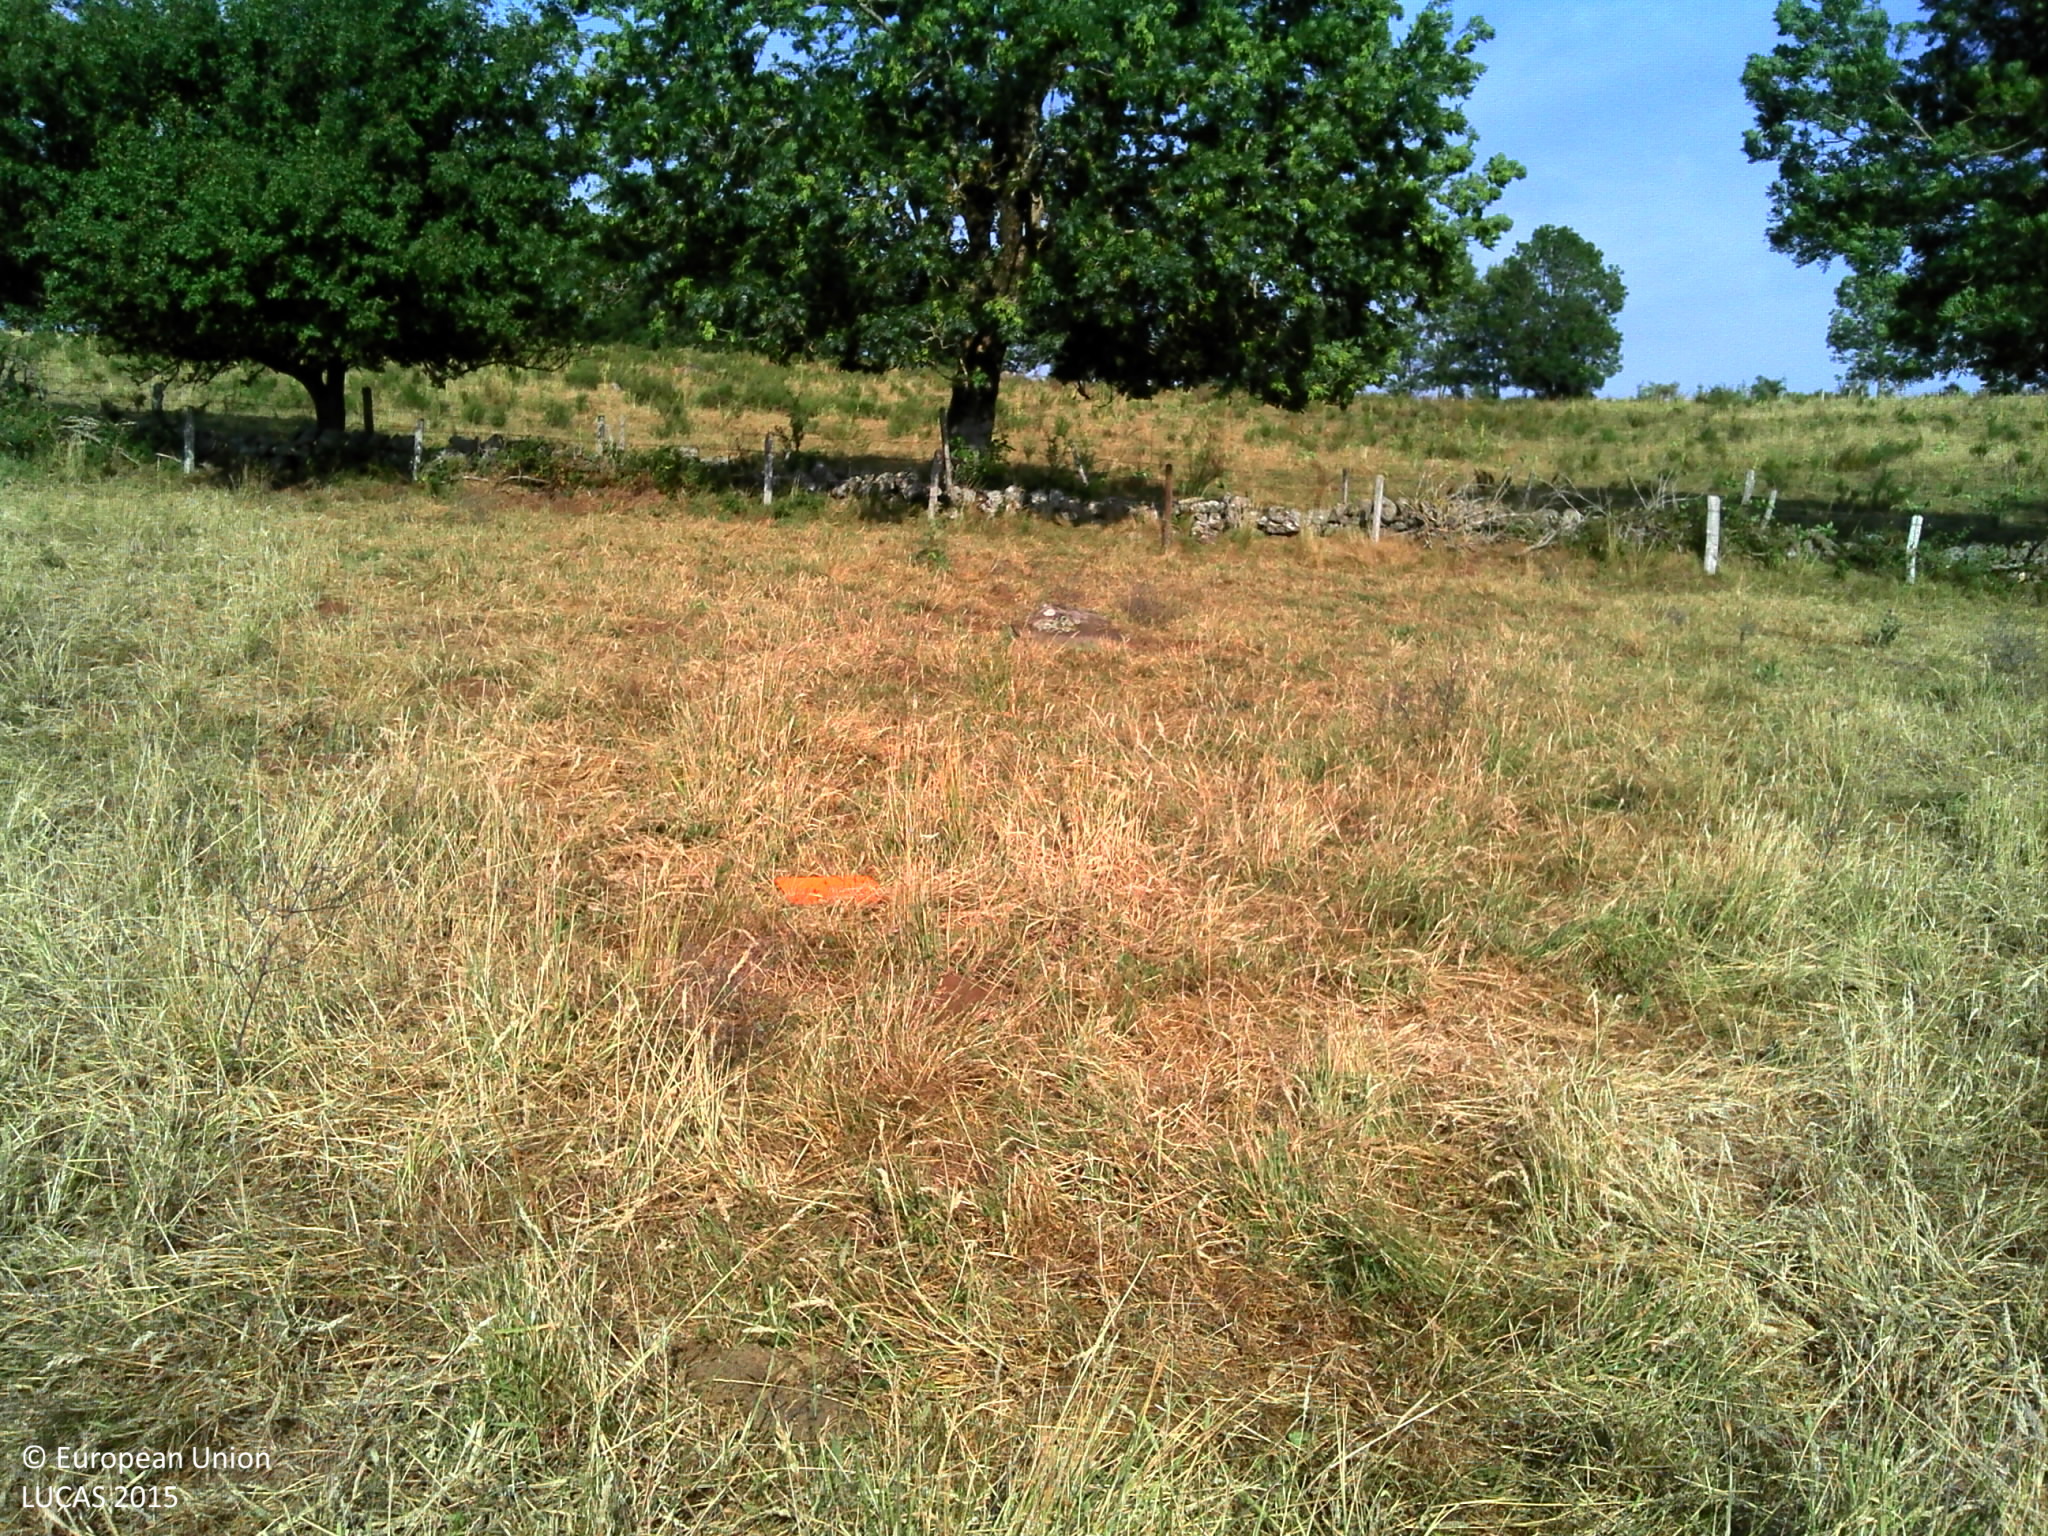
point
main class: Grassland
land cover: Grassland without tree/shrub cover
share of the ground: > 75 %
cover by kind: herbaceous plants 100 %
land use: Agriculture (excluding fallow land and kitchen gardens)
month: July
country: FR
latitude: 44.5804
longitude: 2.9382
